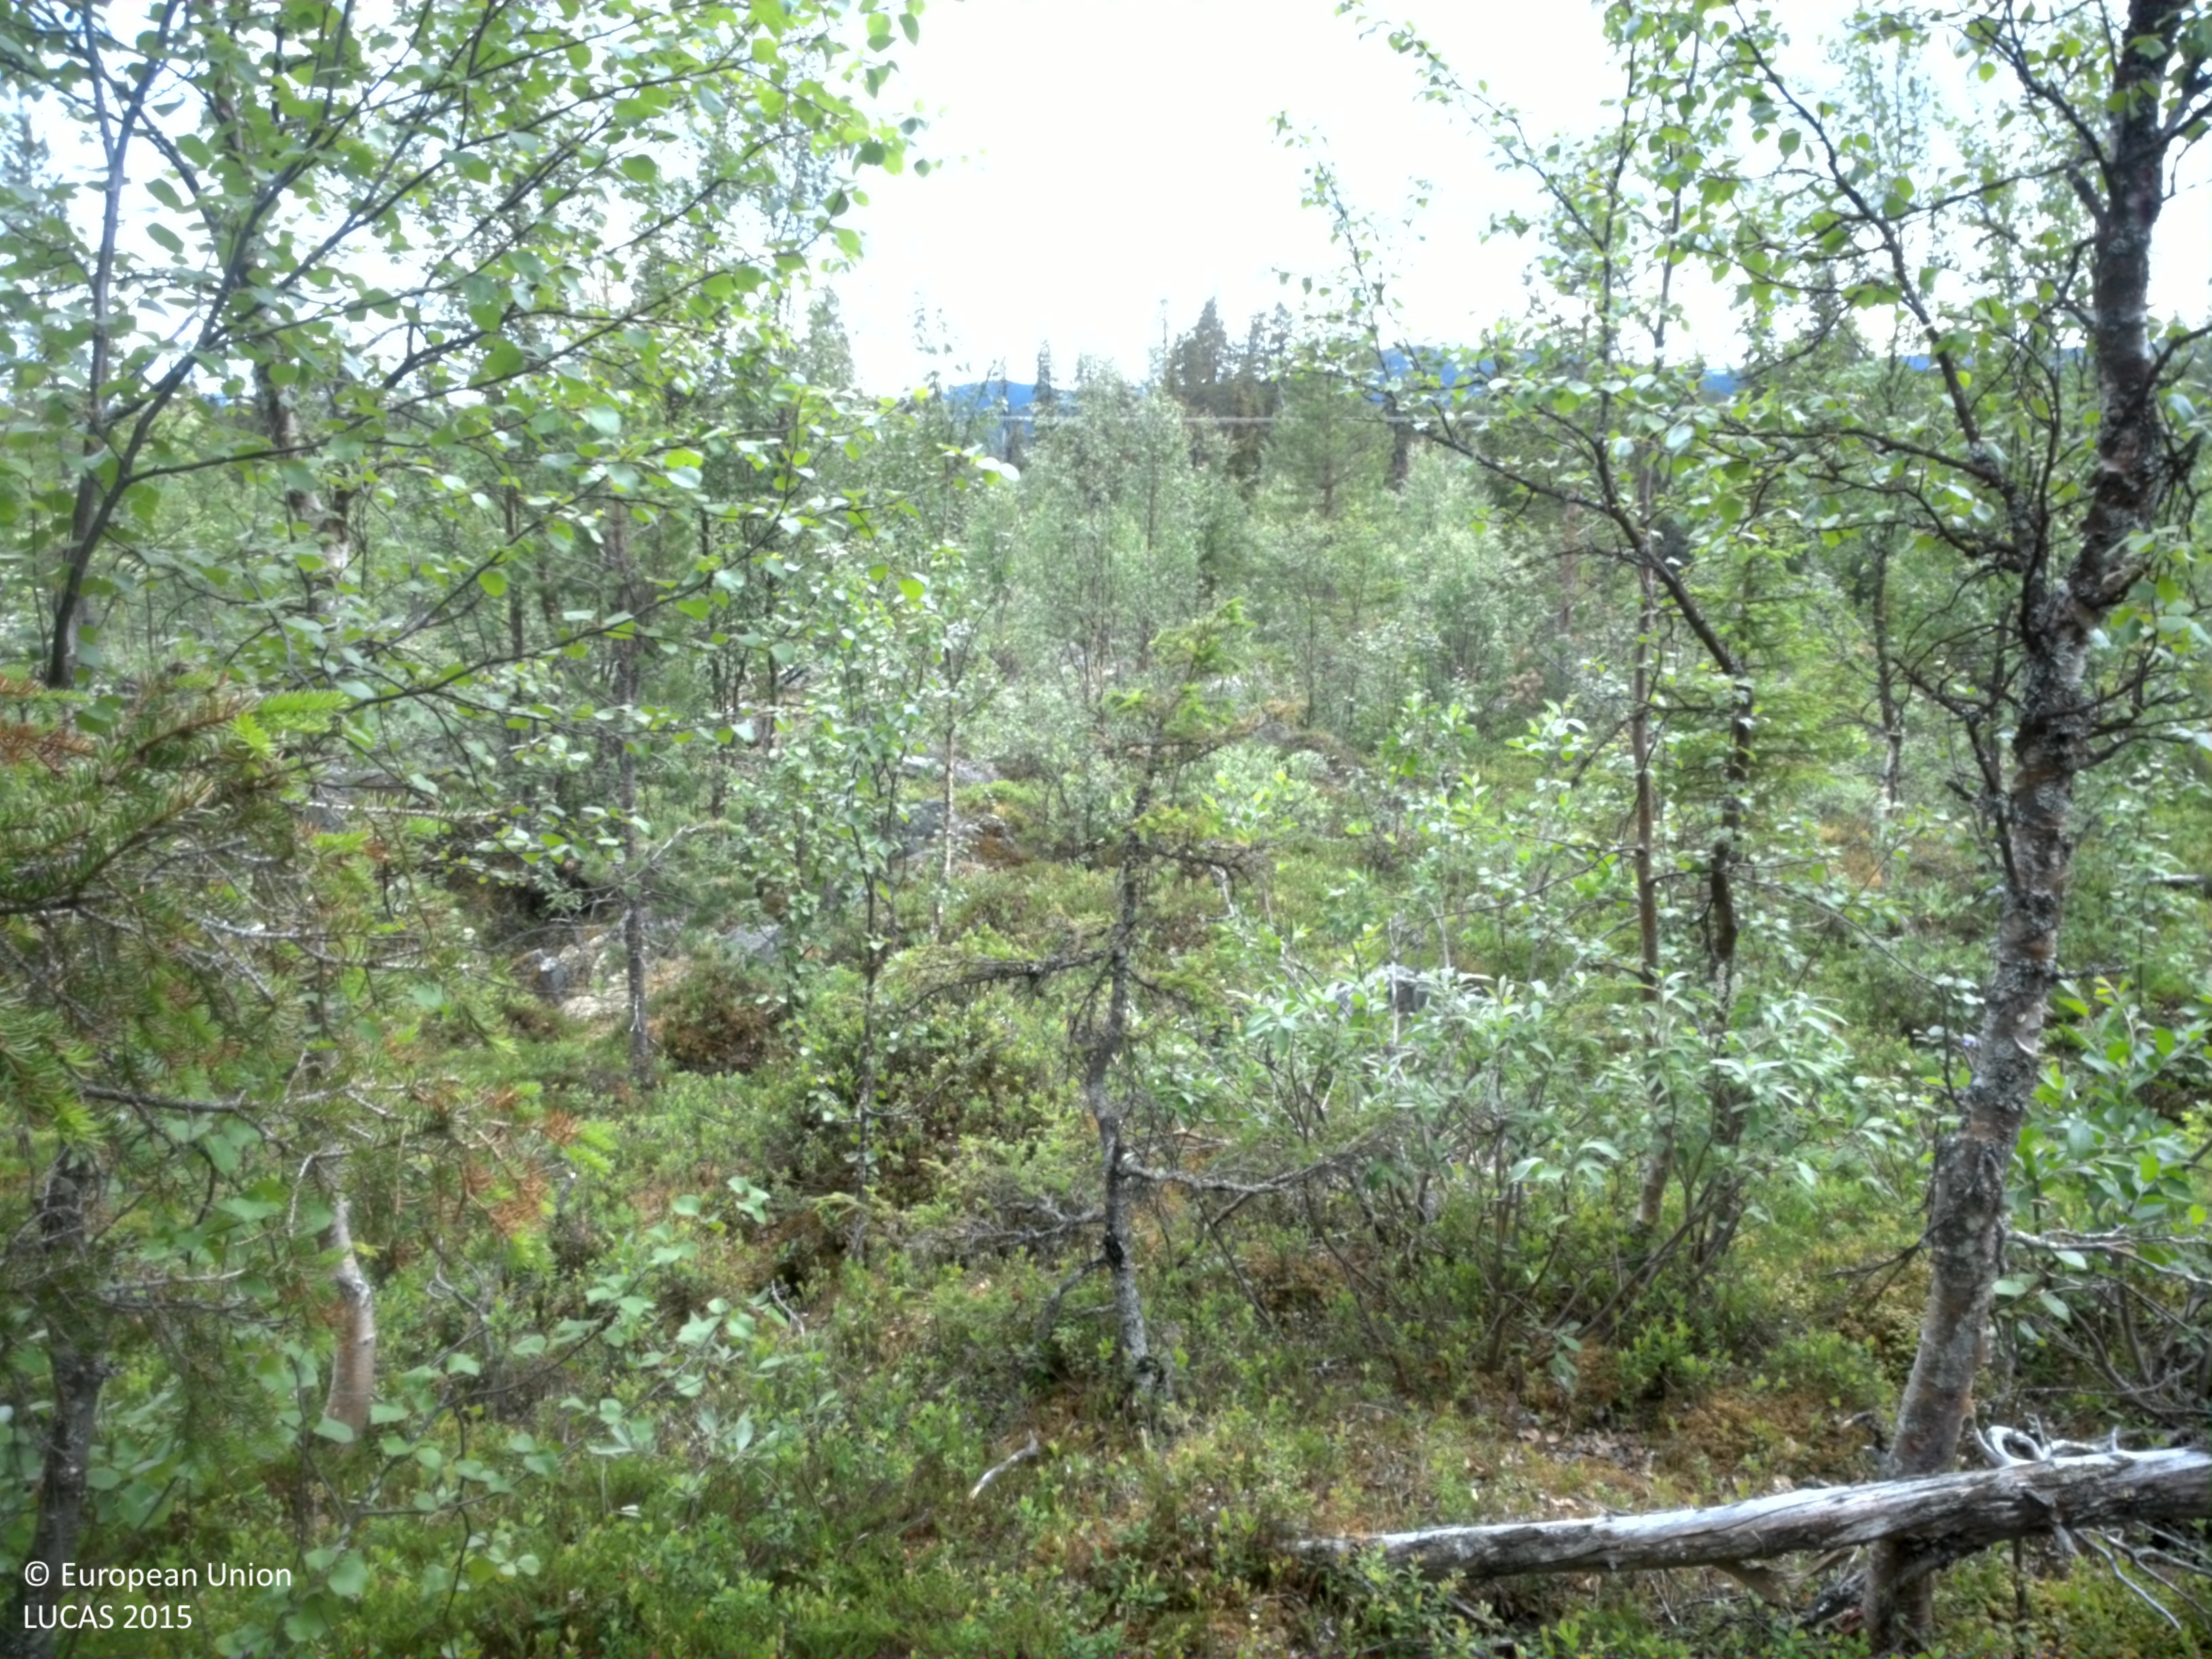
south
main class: Woodland
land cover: Spruce dominated mixed woodland
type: boreal forest
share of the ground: 50 - 75 %
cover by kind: coniferous forest trees 40 %, shrubs 35 %, broadleaved forest trees 20 %, lichens and mosses 5 %
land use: Forestry
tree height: > 5 m
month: July
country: SE
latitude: 67.3141
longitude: 18.9815
